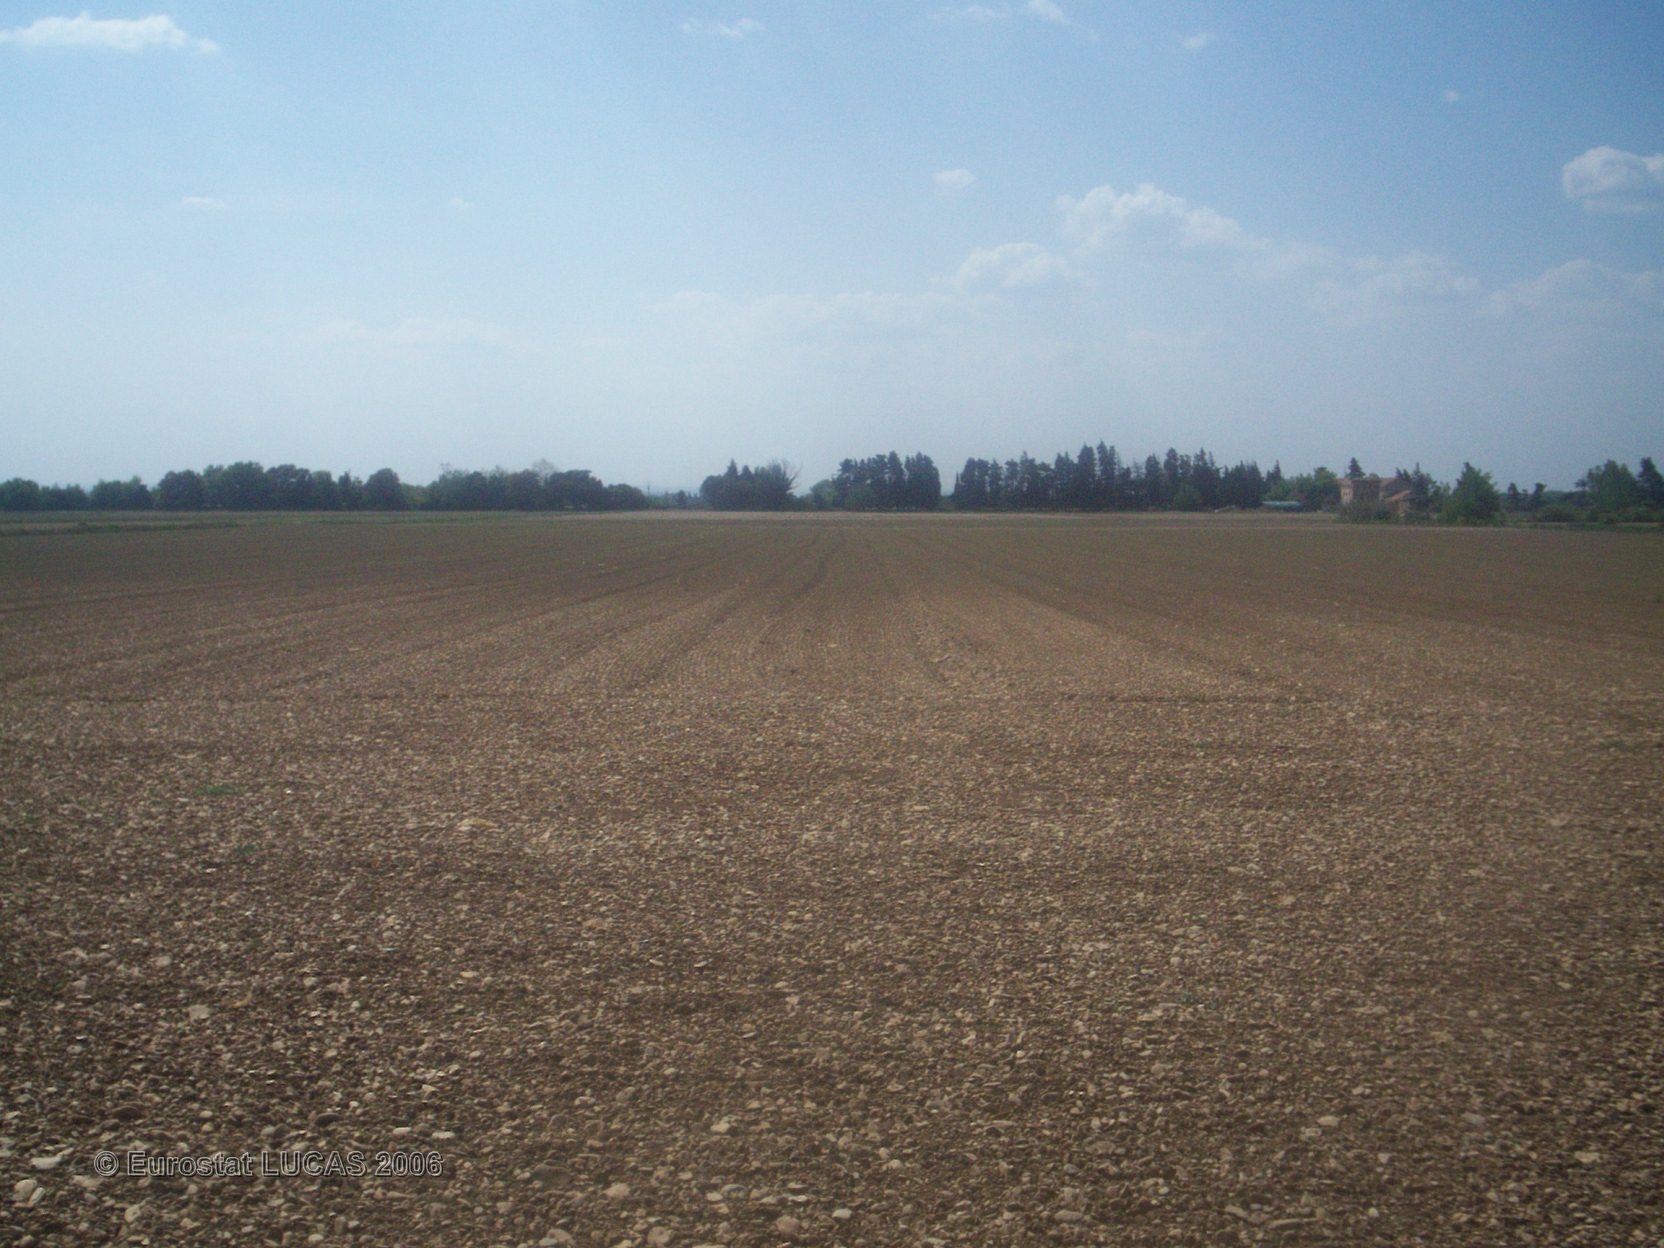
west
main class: Grassland
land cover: Grassland without tree/shrub cover
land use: Agriculture (excluding fallow land and kitchen gardens)
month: June
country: FR
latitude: 44.1371
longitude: 4.9456
